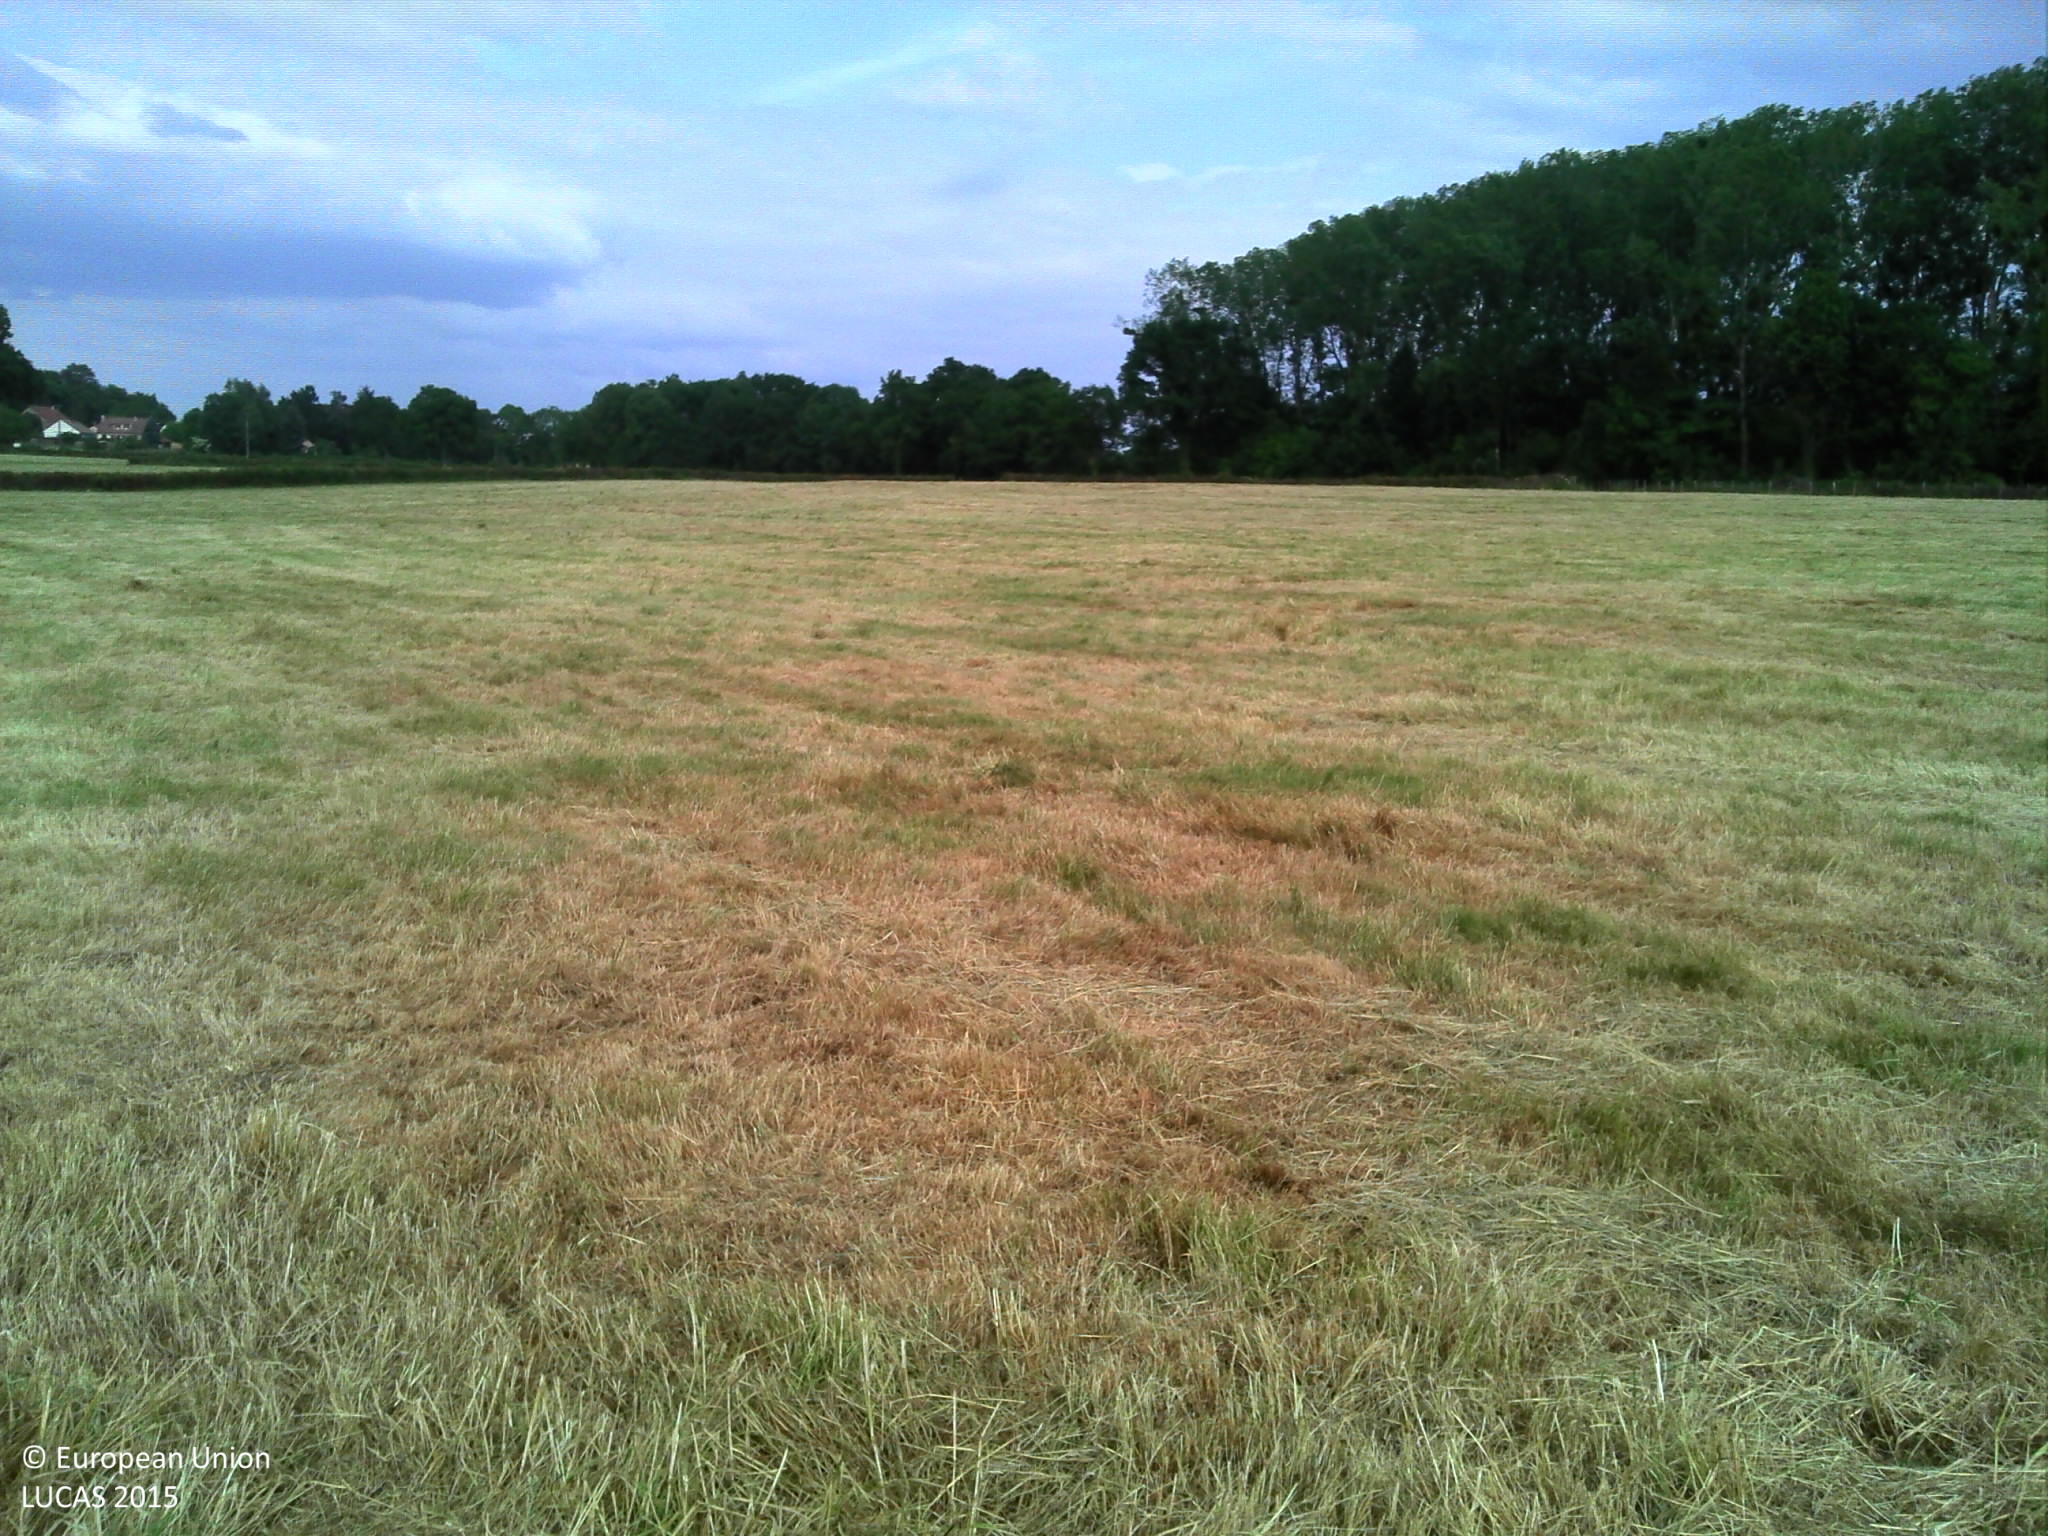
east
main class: Grassland
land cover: Grassland without tree/shrub cover
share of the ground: > 75 %
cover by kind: herbaceous plants 100 %
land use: Agriculture (excluding fallow land and kitchen gardens)
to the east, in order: Grassland without tree/shrub cover; Fences; Managed hedges; Grassland without tree/shrub cover
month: June
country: FR
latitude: 47.4939
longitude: 3.8783
